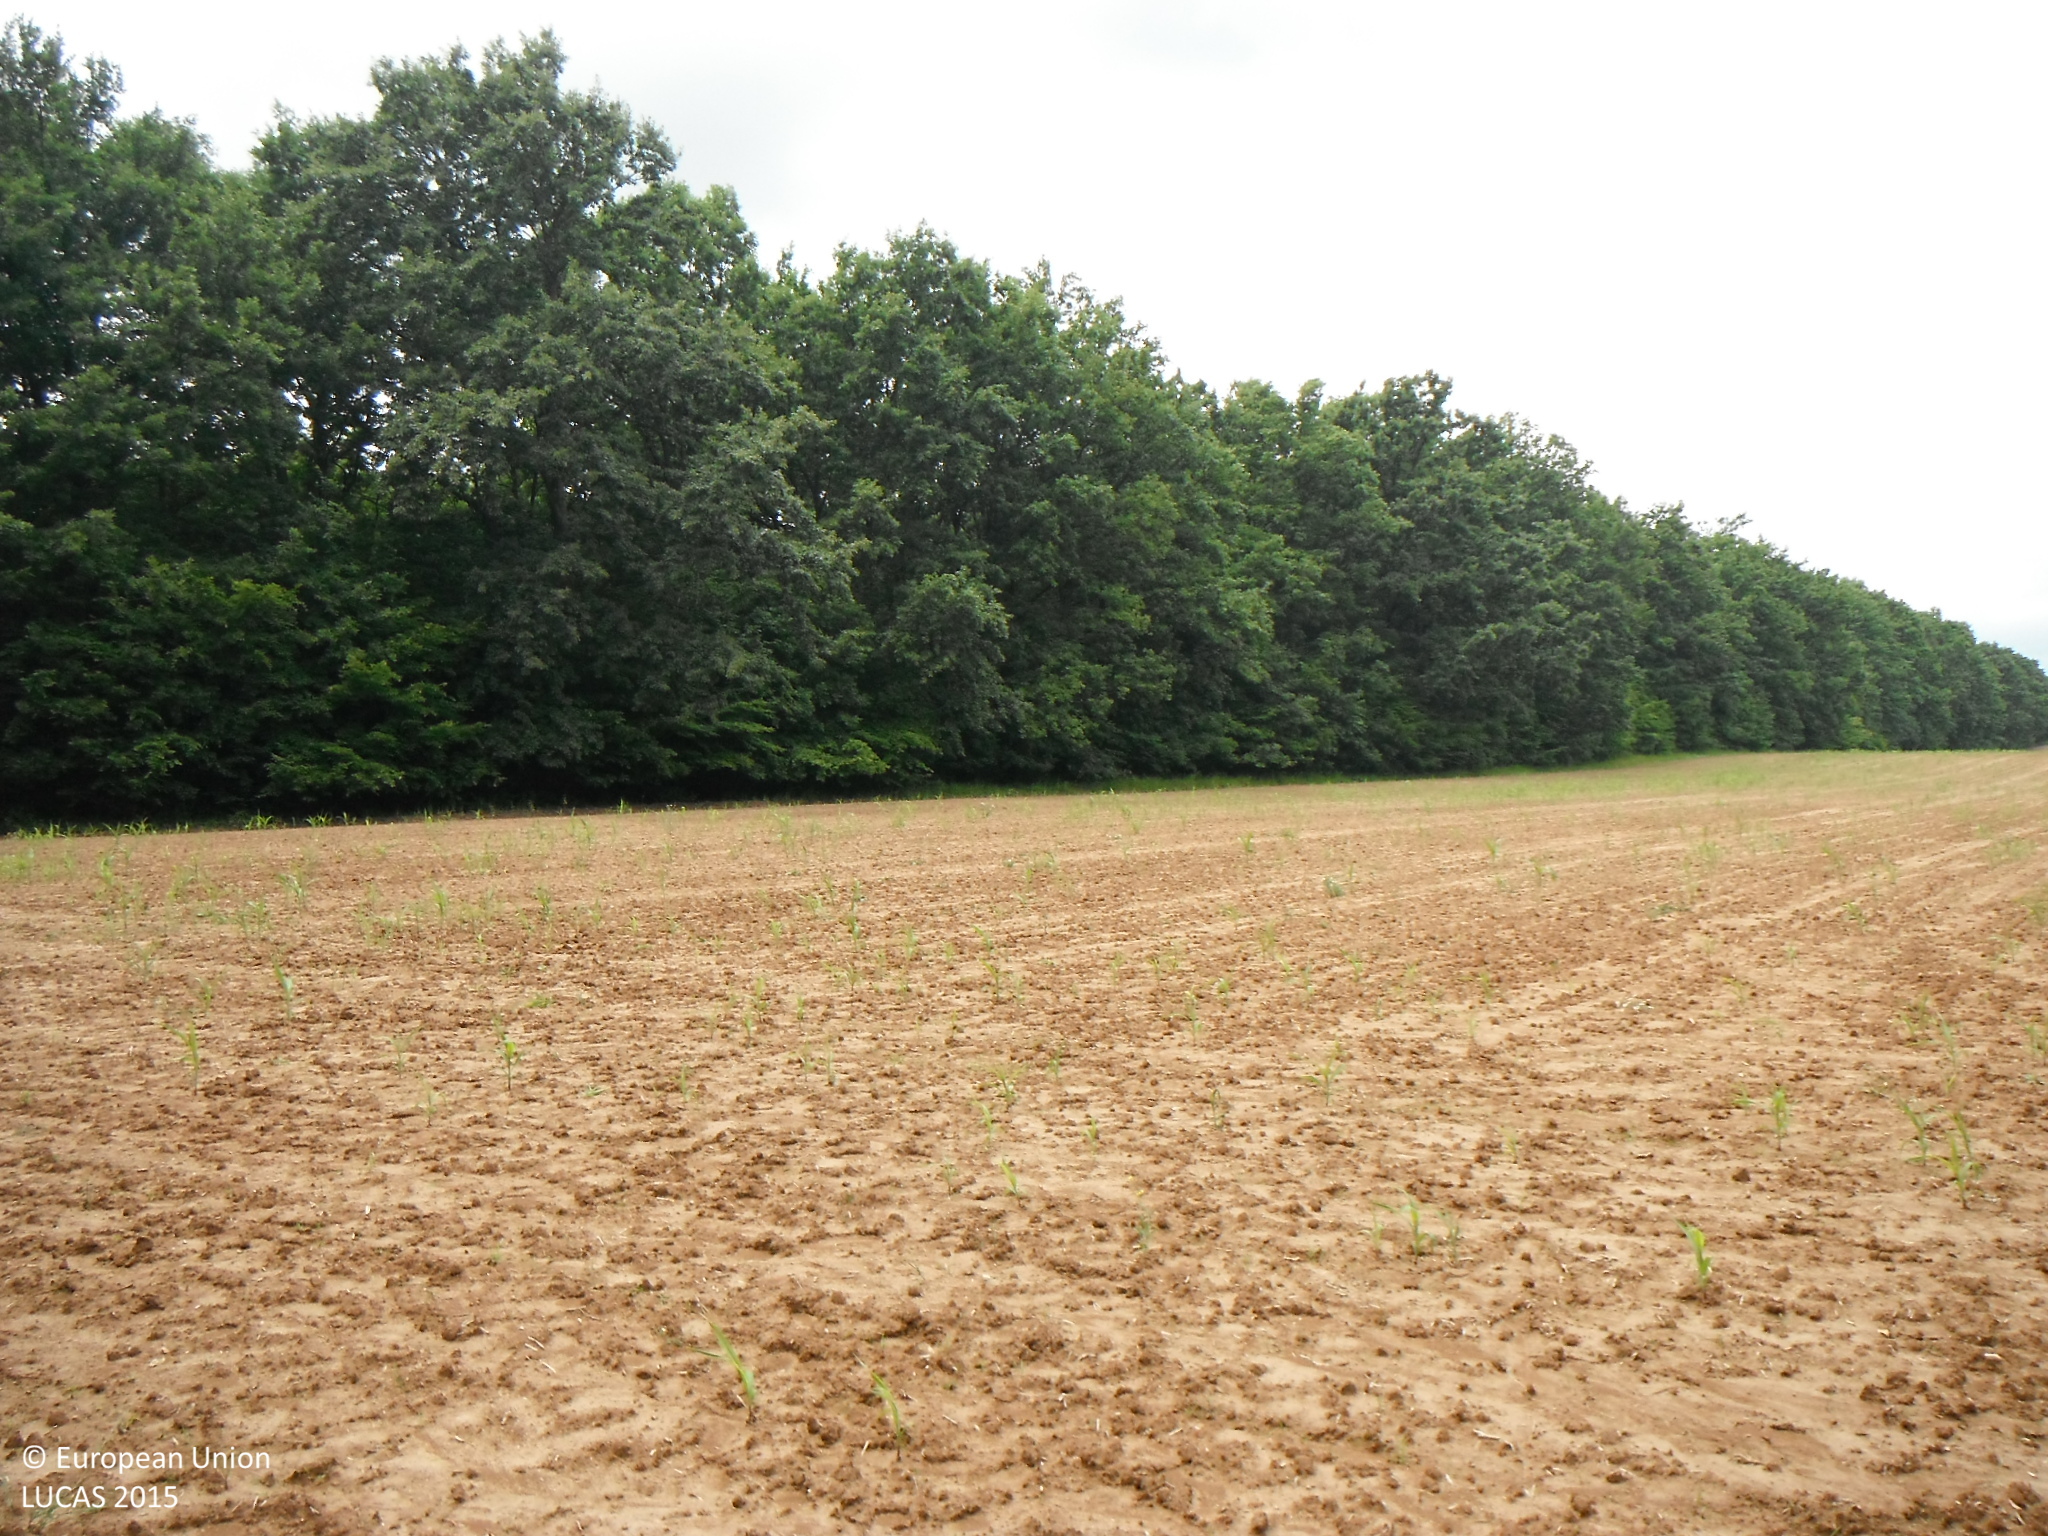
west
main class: Cropland
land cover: Maize
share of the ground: < 10 %
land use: Agriculture (excluding fallow land and kitchen gardens)
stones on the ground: < 10 %
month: June
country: SK
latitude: 48.4644
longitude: 19.9148
